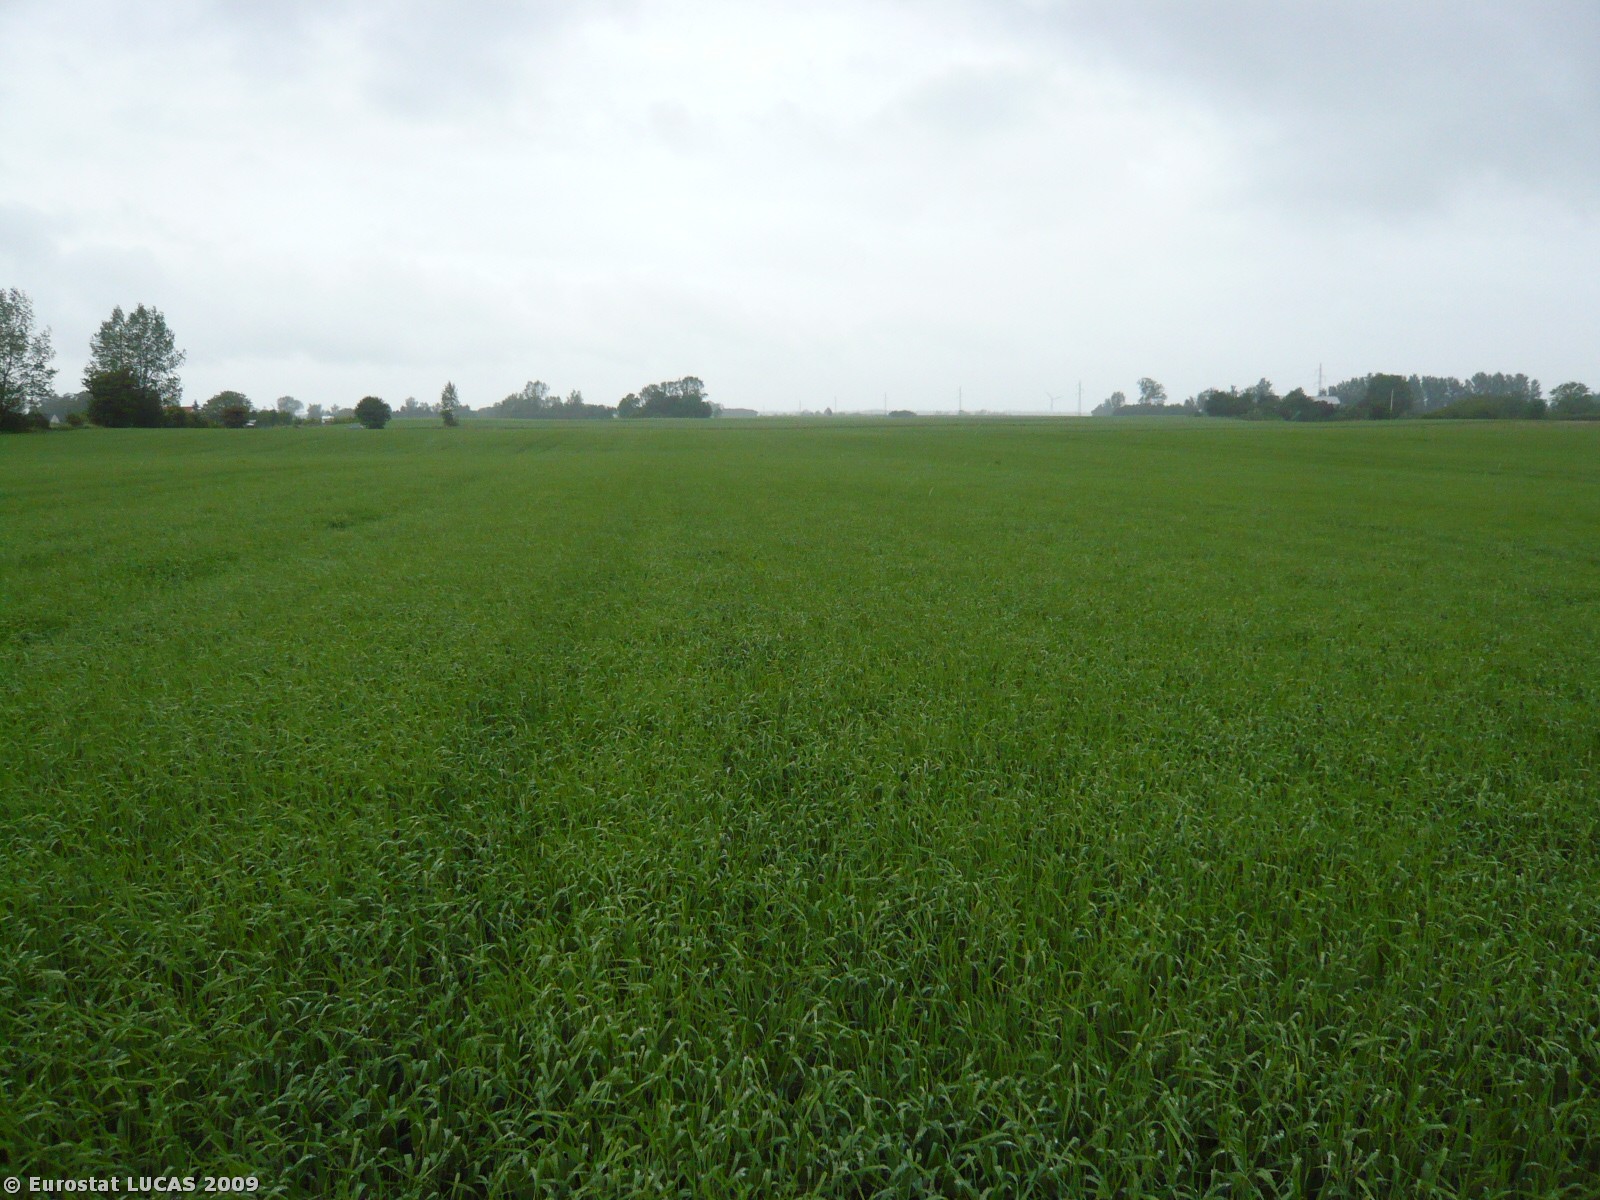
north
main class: Cropland
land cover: Barley
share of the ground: > 75 %
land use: Agriculture (excluding fallow land and kitchen gardens)
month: June
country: DK
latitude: 54.7891
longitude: 11.9116
